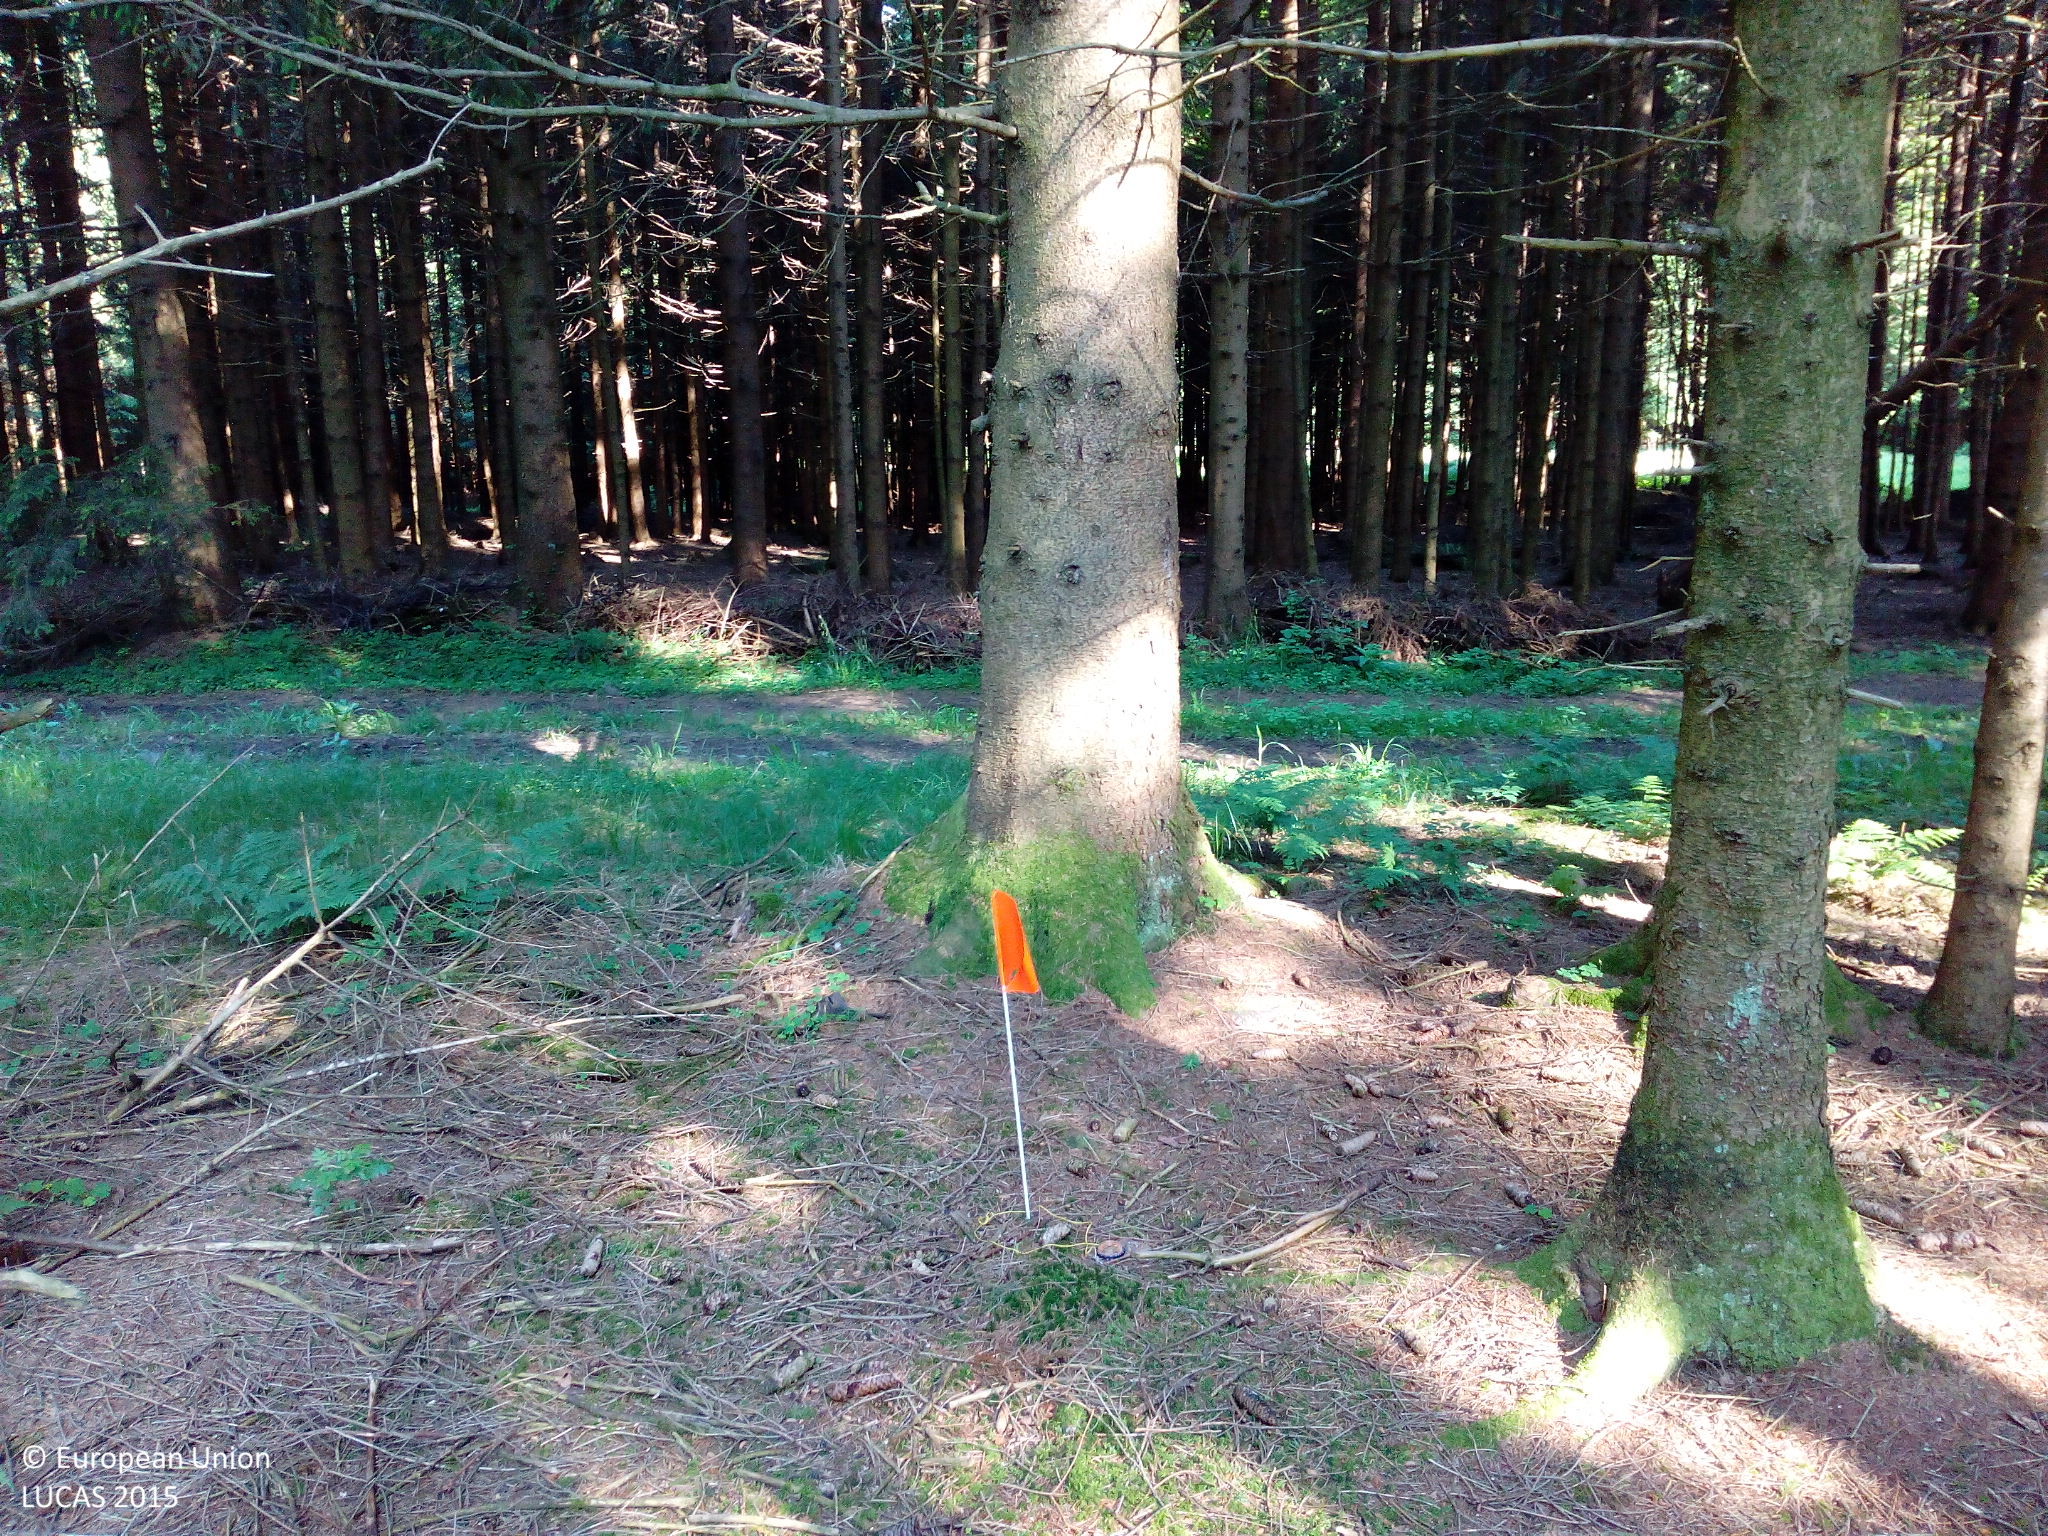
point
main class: Woodland
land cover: Spruce dominated coniferous woodland
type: hemiboreal forest and nemoral coniferous forest and mixed broadleaved-coniferous forest
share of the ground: > 75 %
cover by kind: coniferous forest trees 90 %, broadleaved forest trees 5 %, unconsolidated bare surface 5 %
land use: Forestry
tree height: > 5 m
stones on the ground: < 10 %
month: June
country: DE
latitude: 47.8927
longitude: 12.3393
